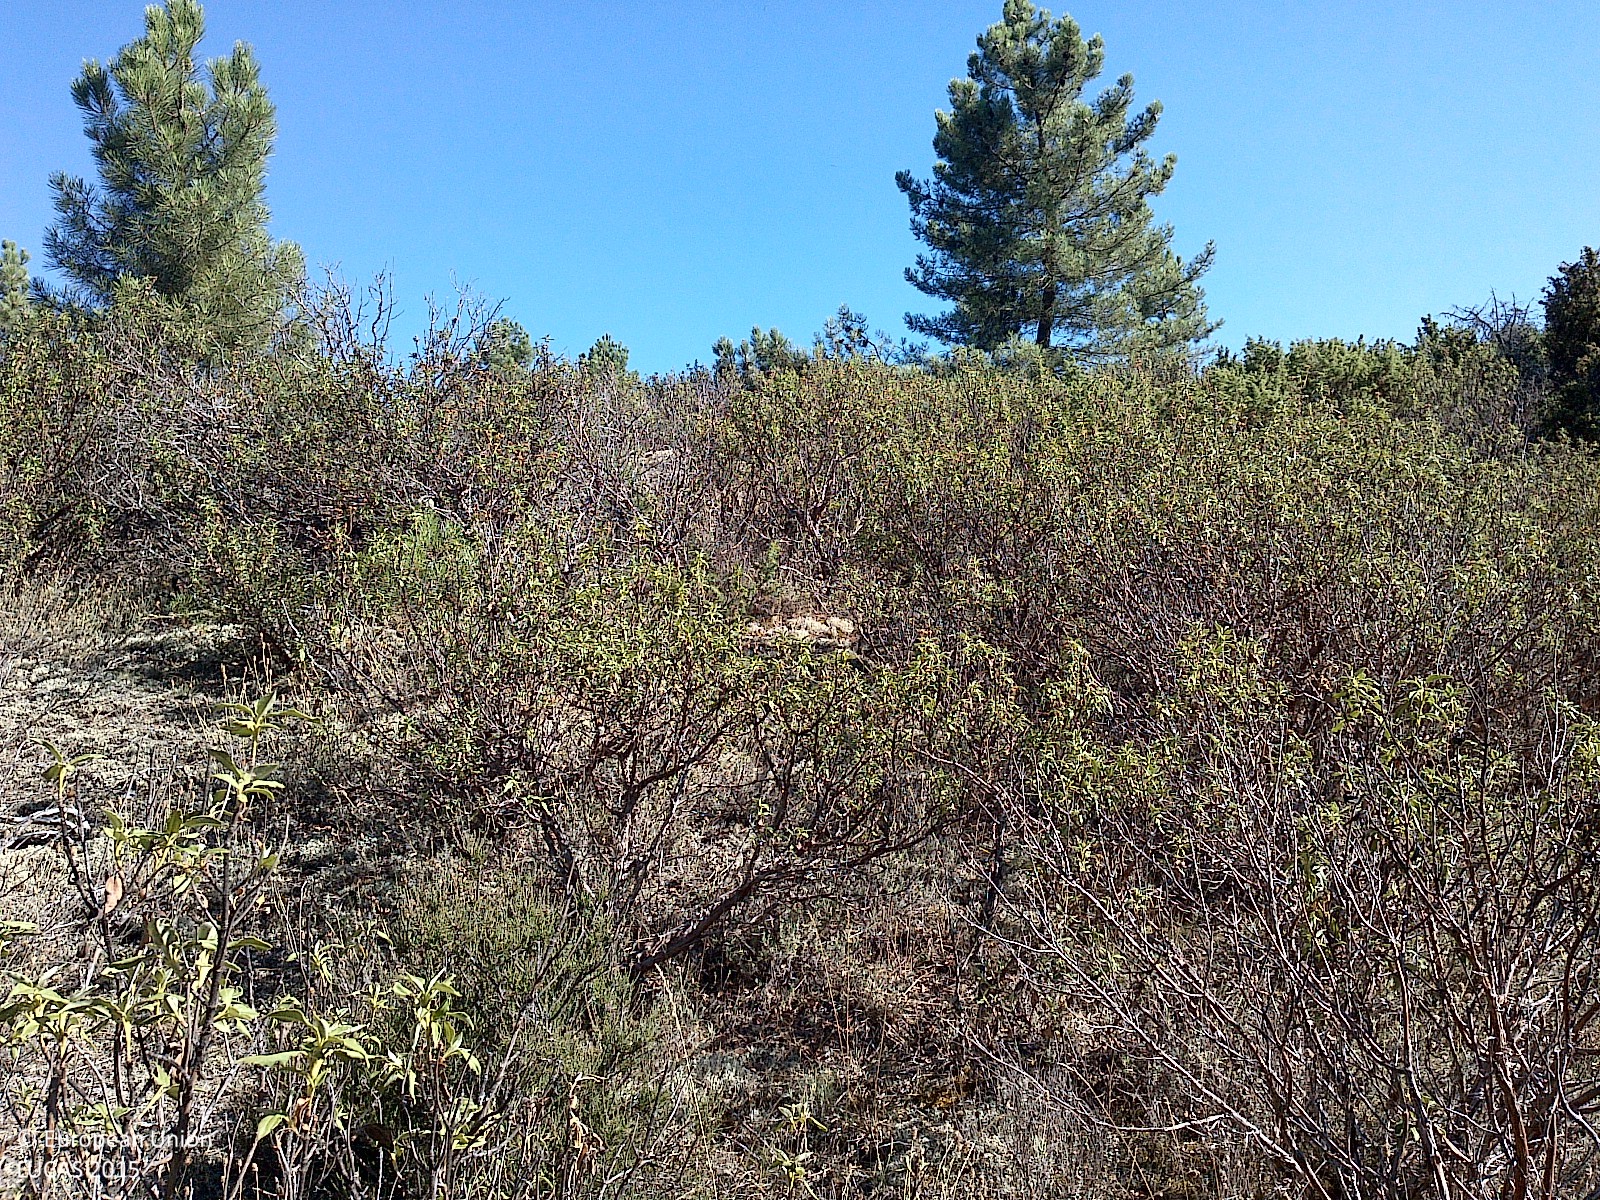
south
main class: Woodland
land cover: Pine dominated coniferous woodland
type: coniferous forest of the mediterranean region
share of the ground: 25 - 50 %
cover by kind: coniferous forest trees 40 %, shrubs 35 %, herbaceous plants 25 %
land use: Forestry
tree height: > 5 m
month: July
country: ES
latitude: 41.9072
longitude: -3.2498
